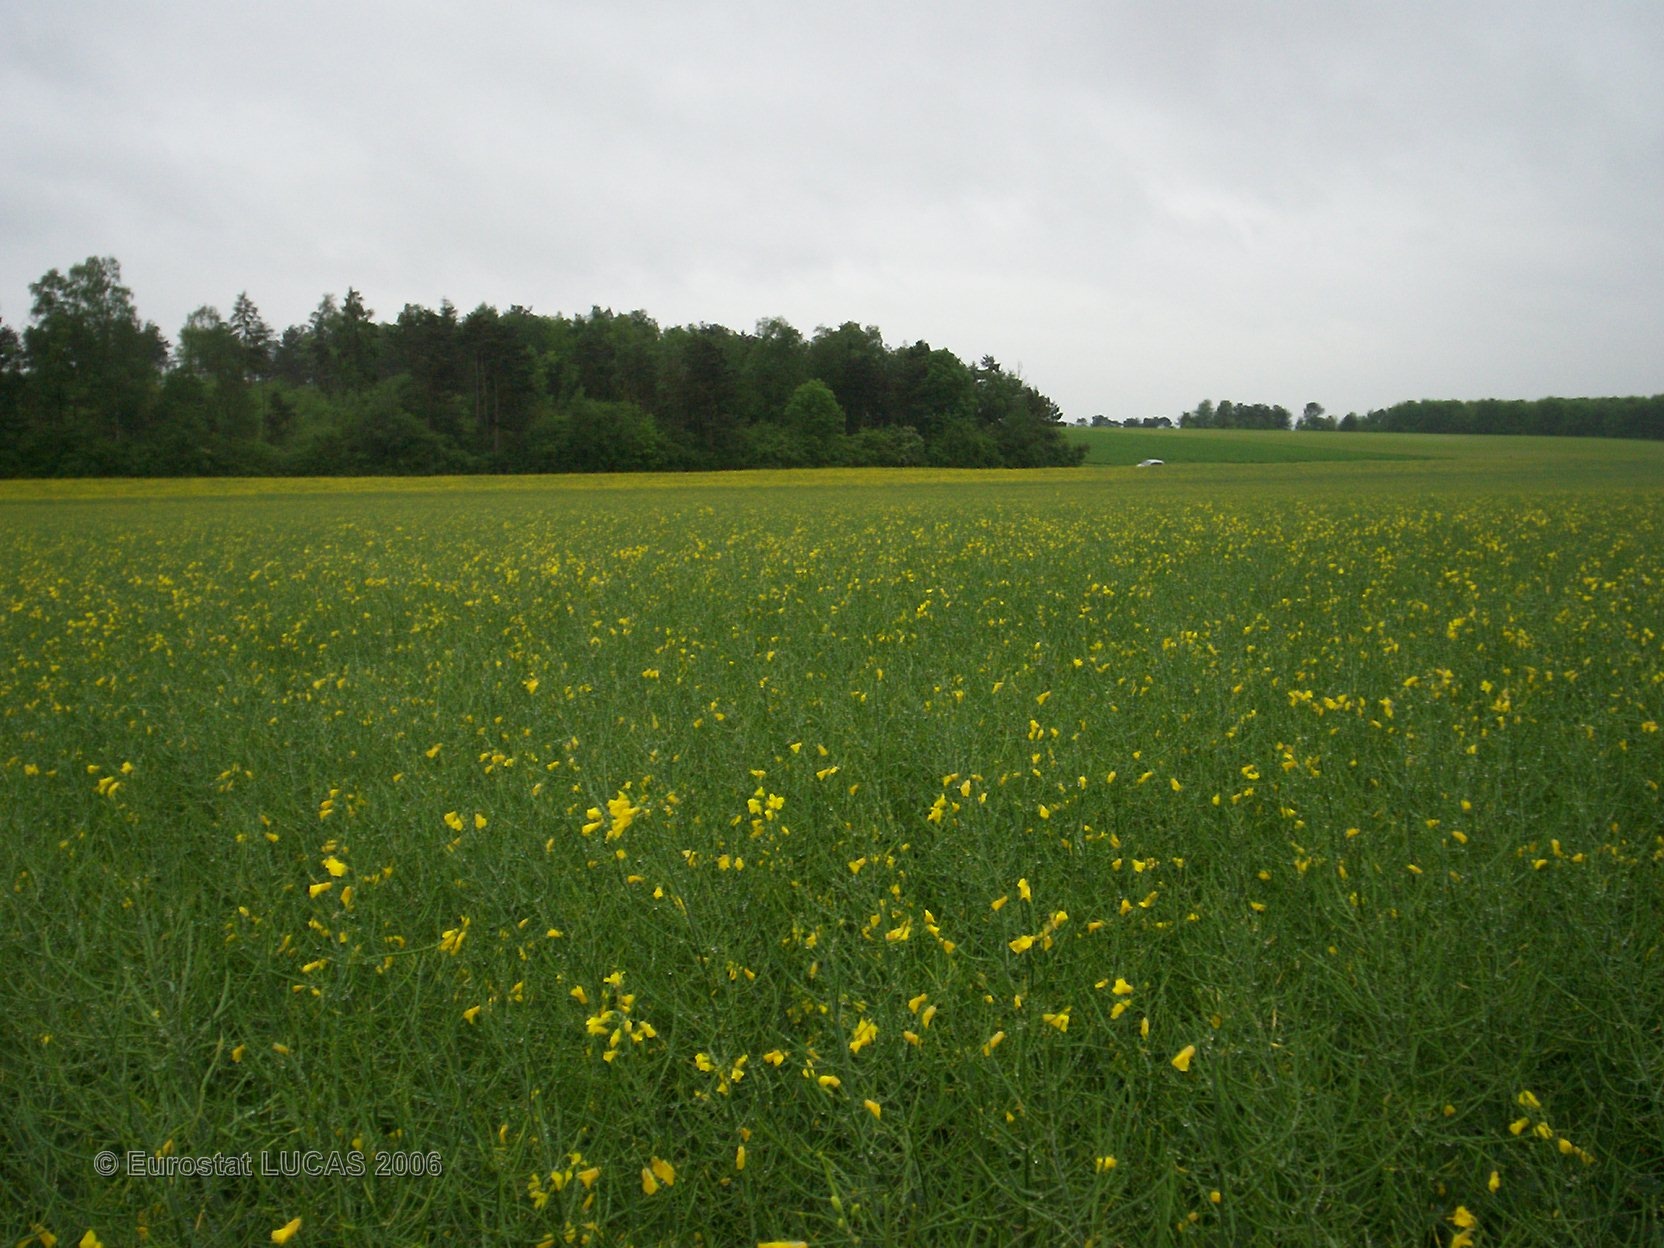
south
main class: Cropland
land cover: Rape and turnip rape
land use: Agriculture (excluding fallow land and kitchen gardens)
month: May
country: FR
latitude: 49.4177
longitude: 4.4409
